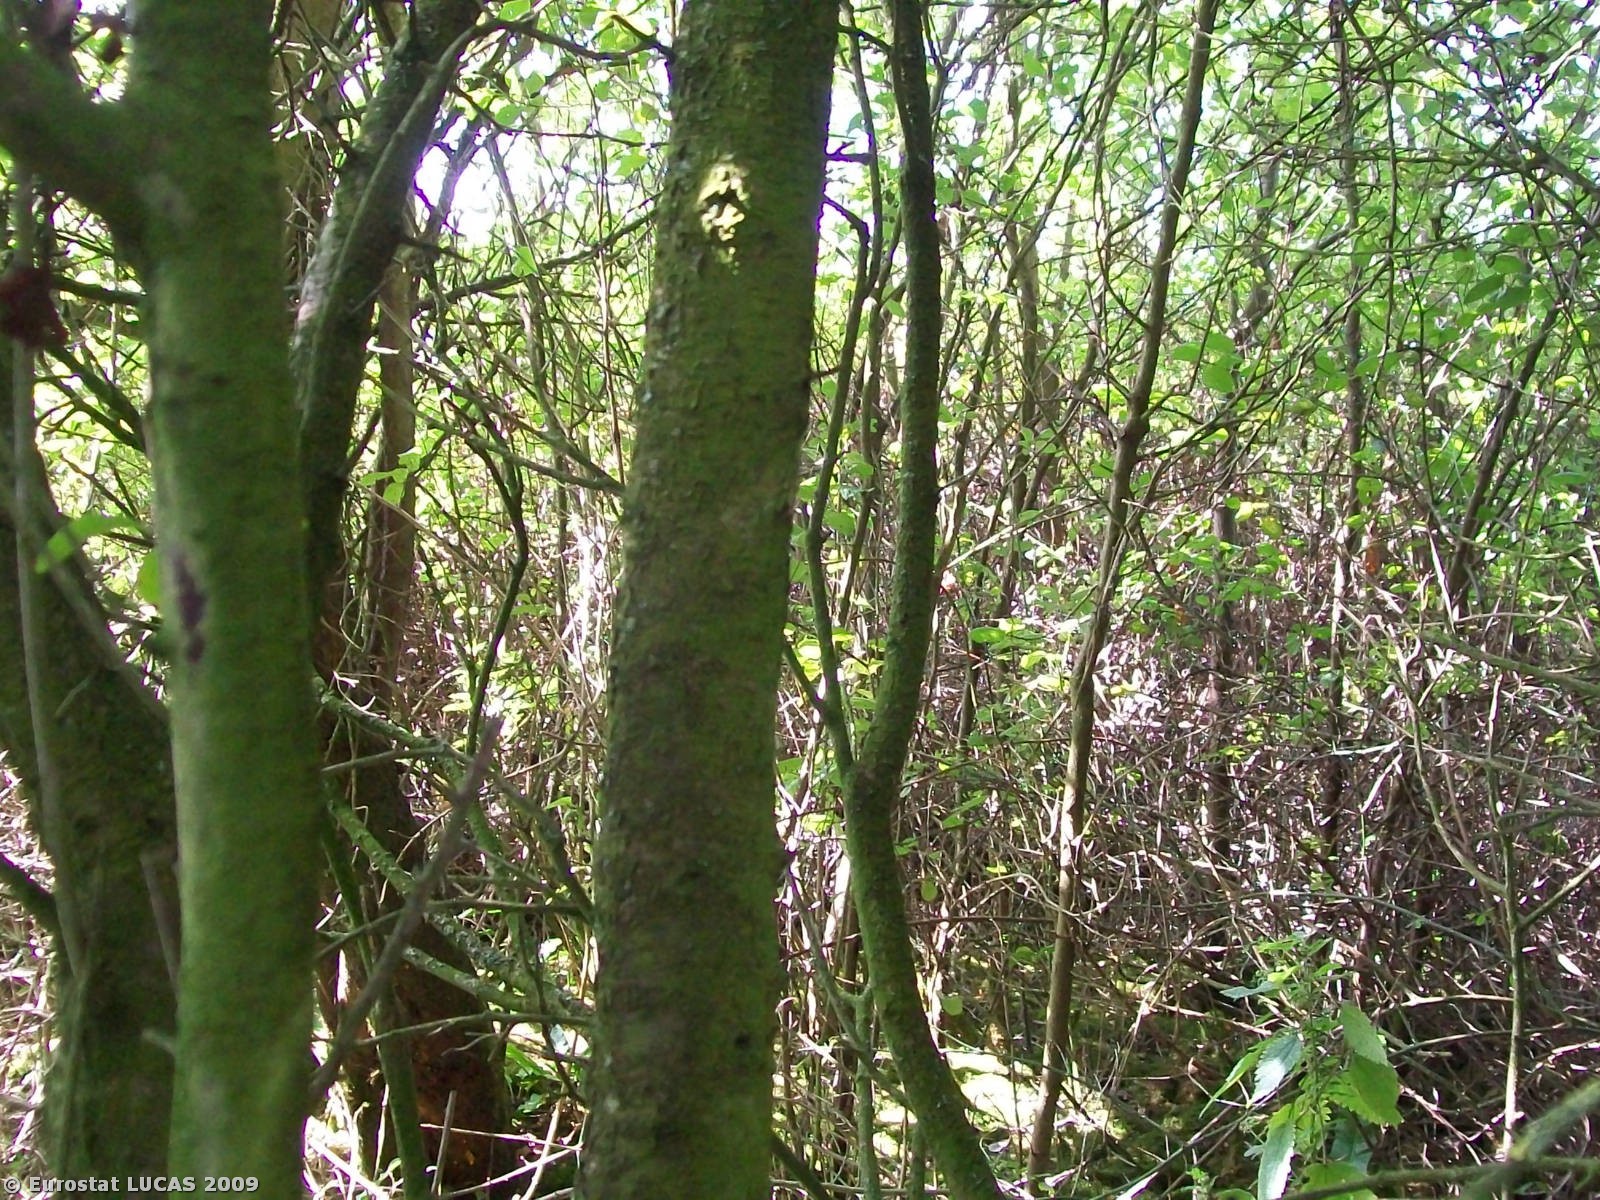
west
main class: Woodland
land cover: Broadleaved woodland
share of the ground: > 75 %
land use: Unused
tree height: > 5 m
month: August
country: GB
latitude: 51.6021
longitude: -2.3506
